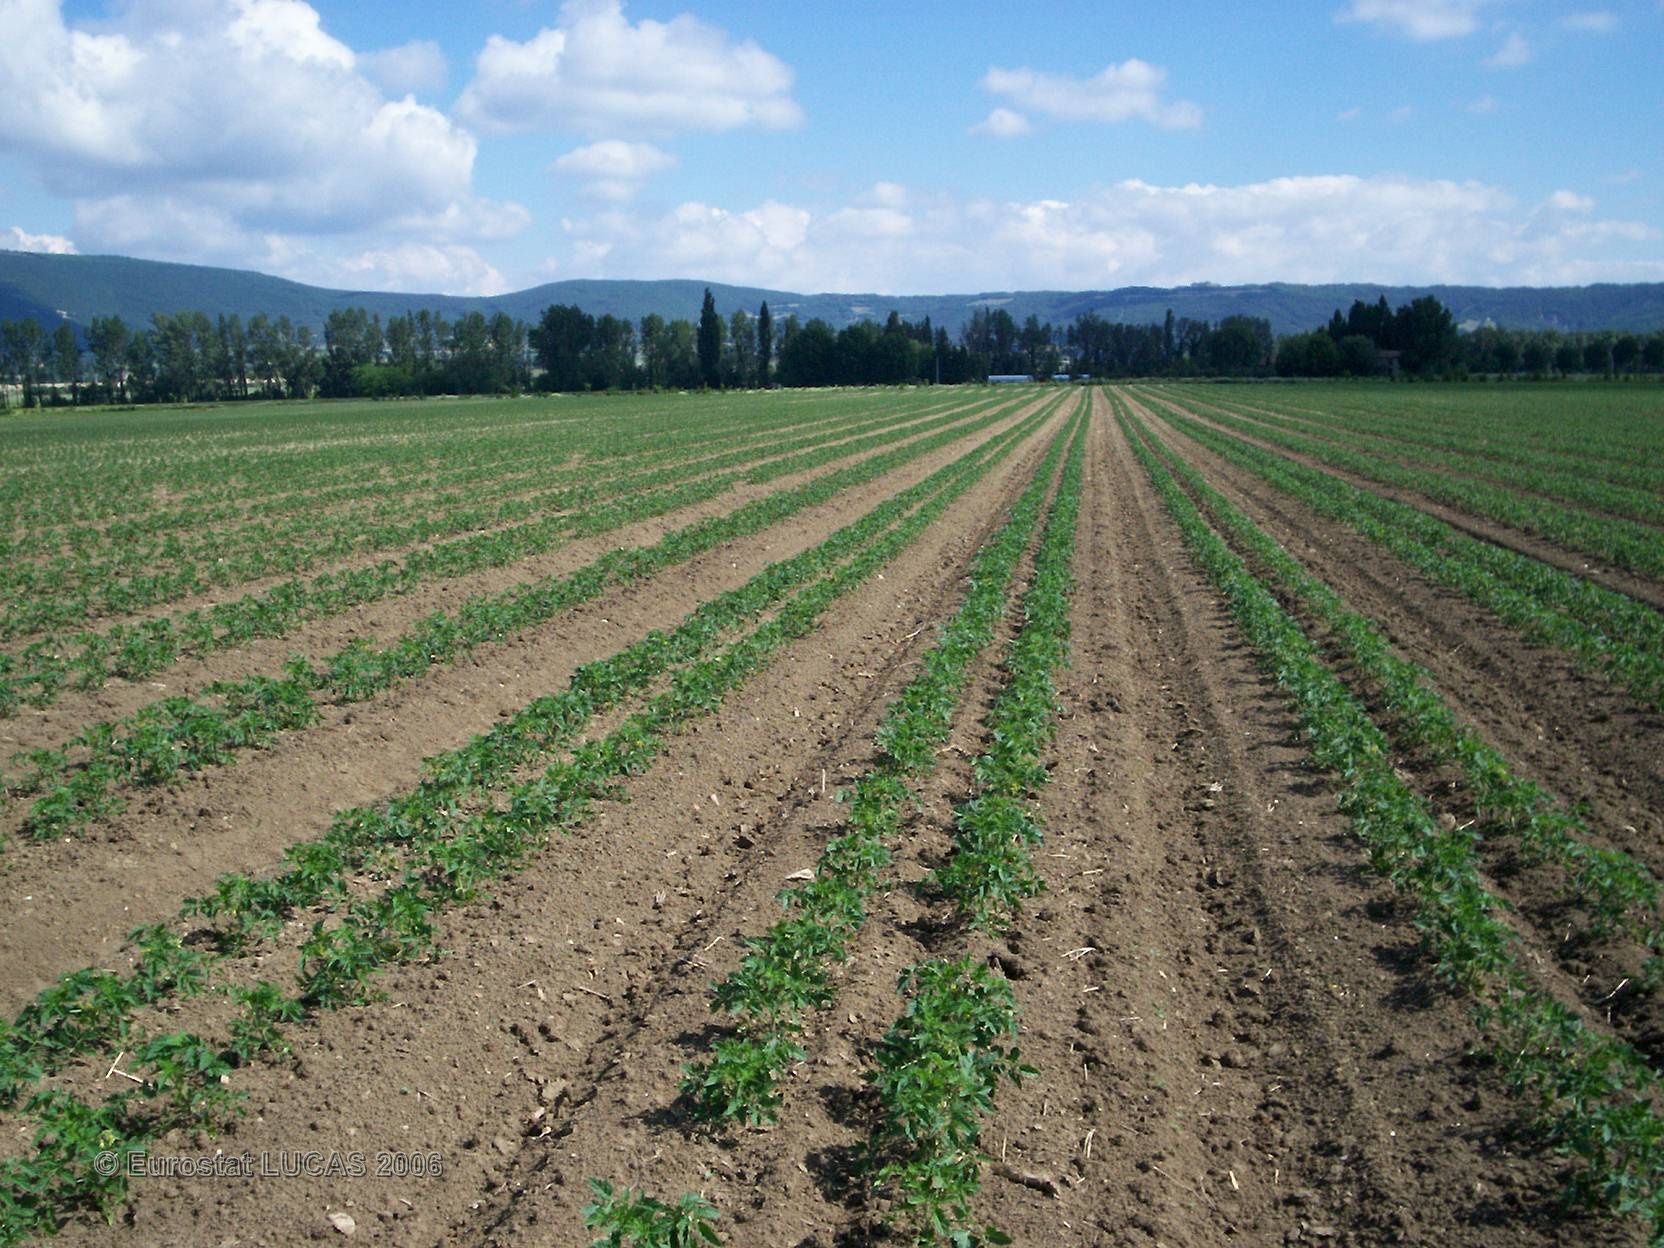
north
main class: Cropland
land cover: Tomatoes
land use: Agriculture (excluding fallow land and kitchen gardens)
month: May
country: FR
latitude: 44.6228
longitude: 4.9022
